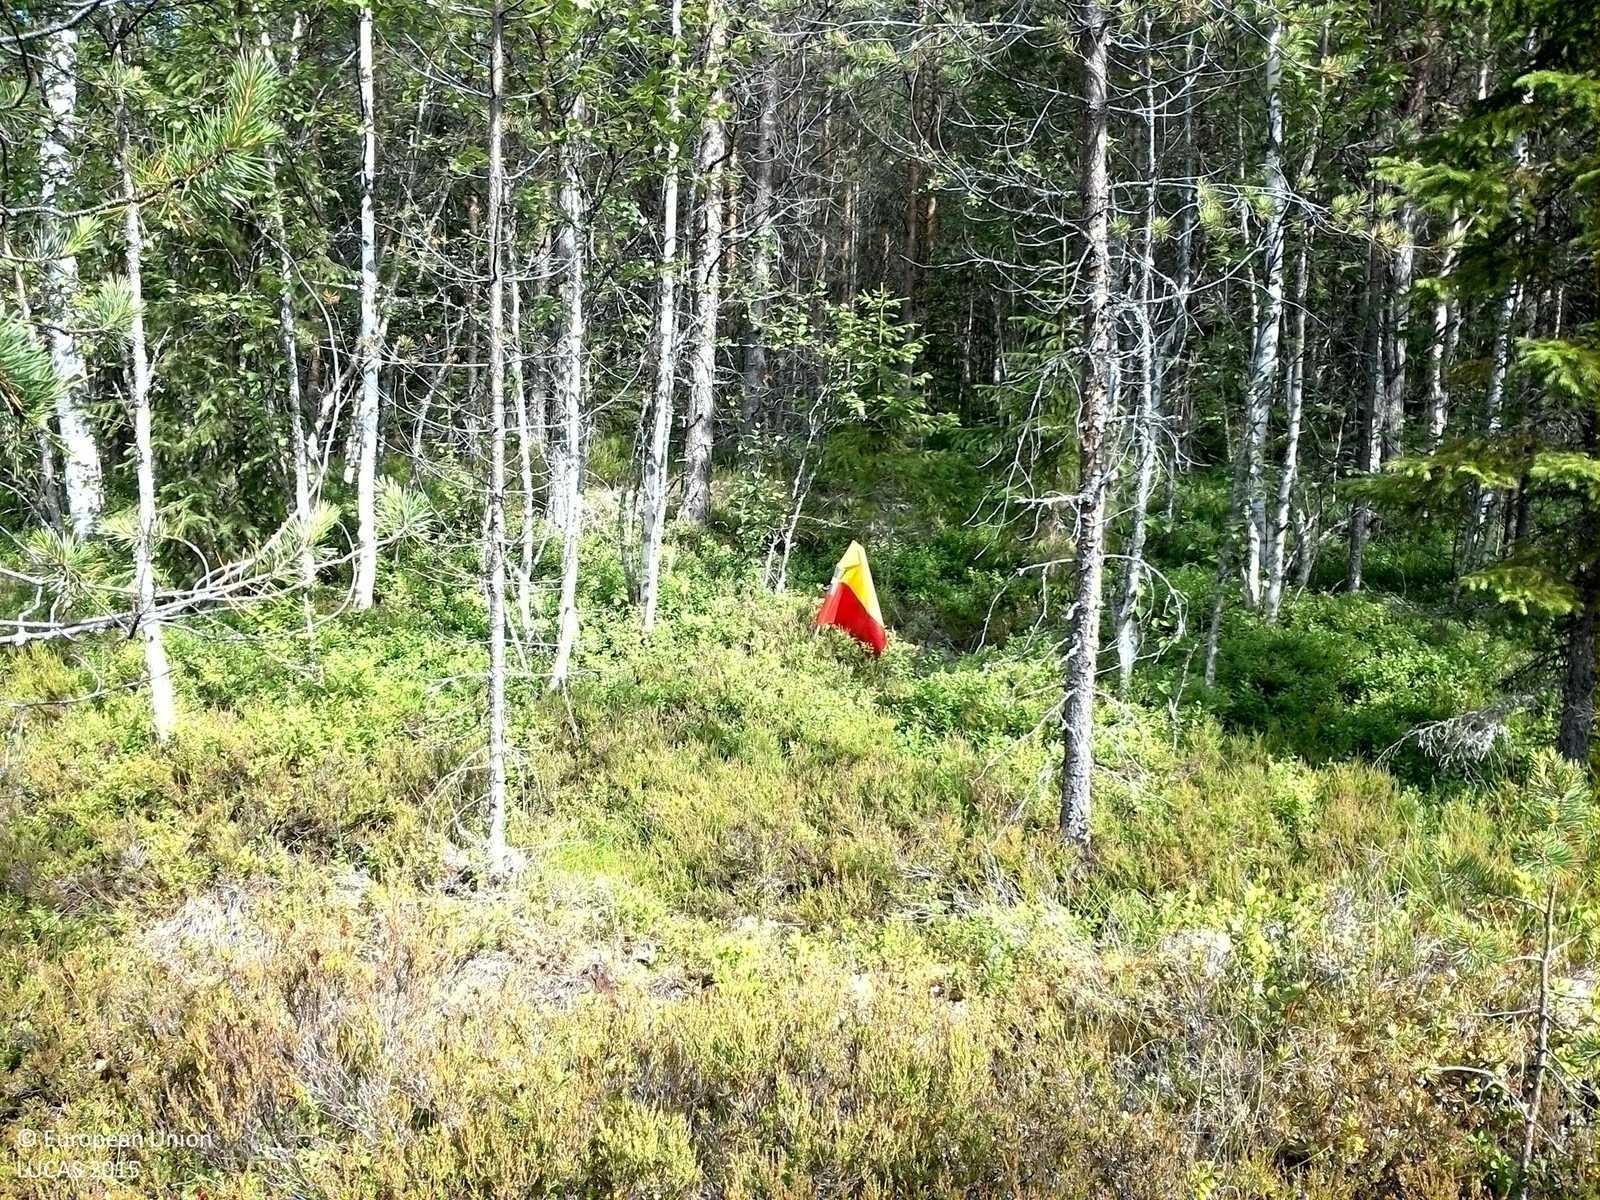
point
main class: Woodland
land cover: Pine dominated coniferous woodland
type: boreal forest
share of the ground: 50 - 75 %
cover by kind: coniferous forest trees 55 %, shrubs 25 %, broadleaved forest trees 10 %, lichens and mosses 10 %
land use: Forestry
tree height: > 5 m
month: August
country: SE
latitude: 63.7944
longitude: 16.4874
